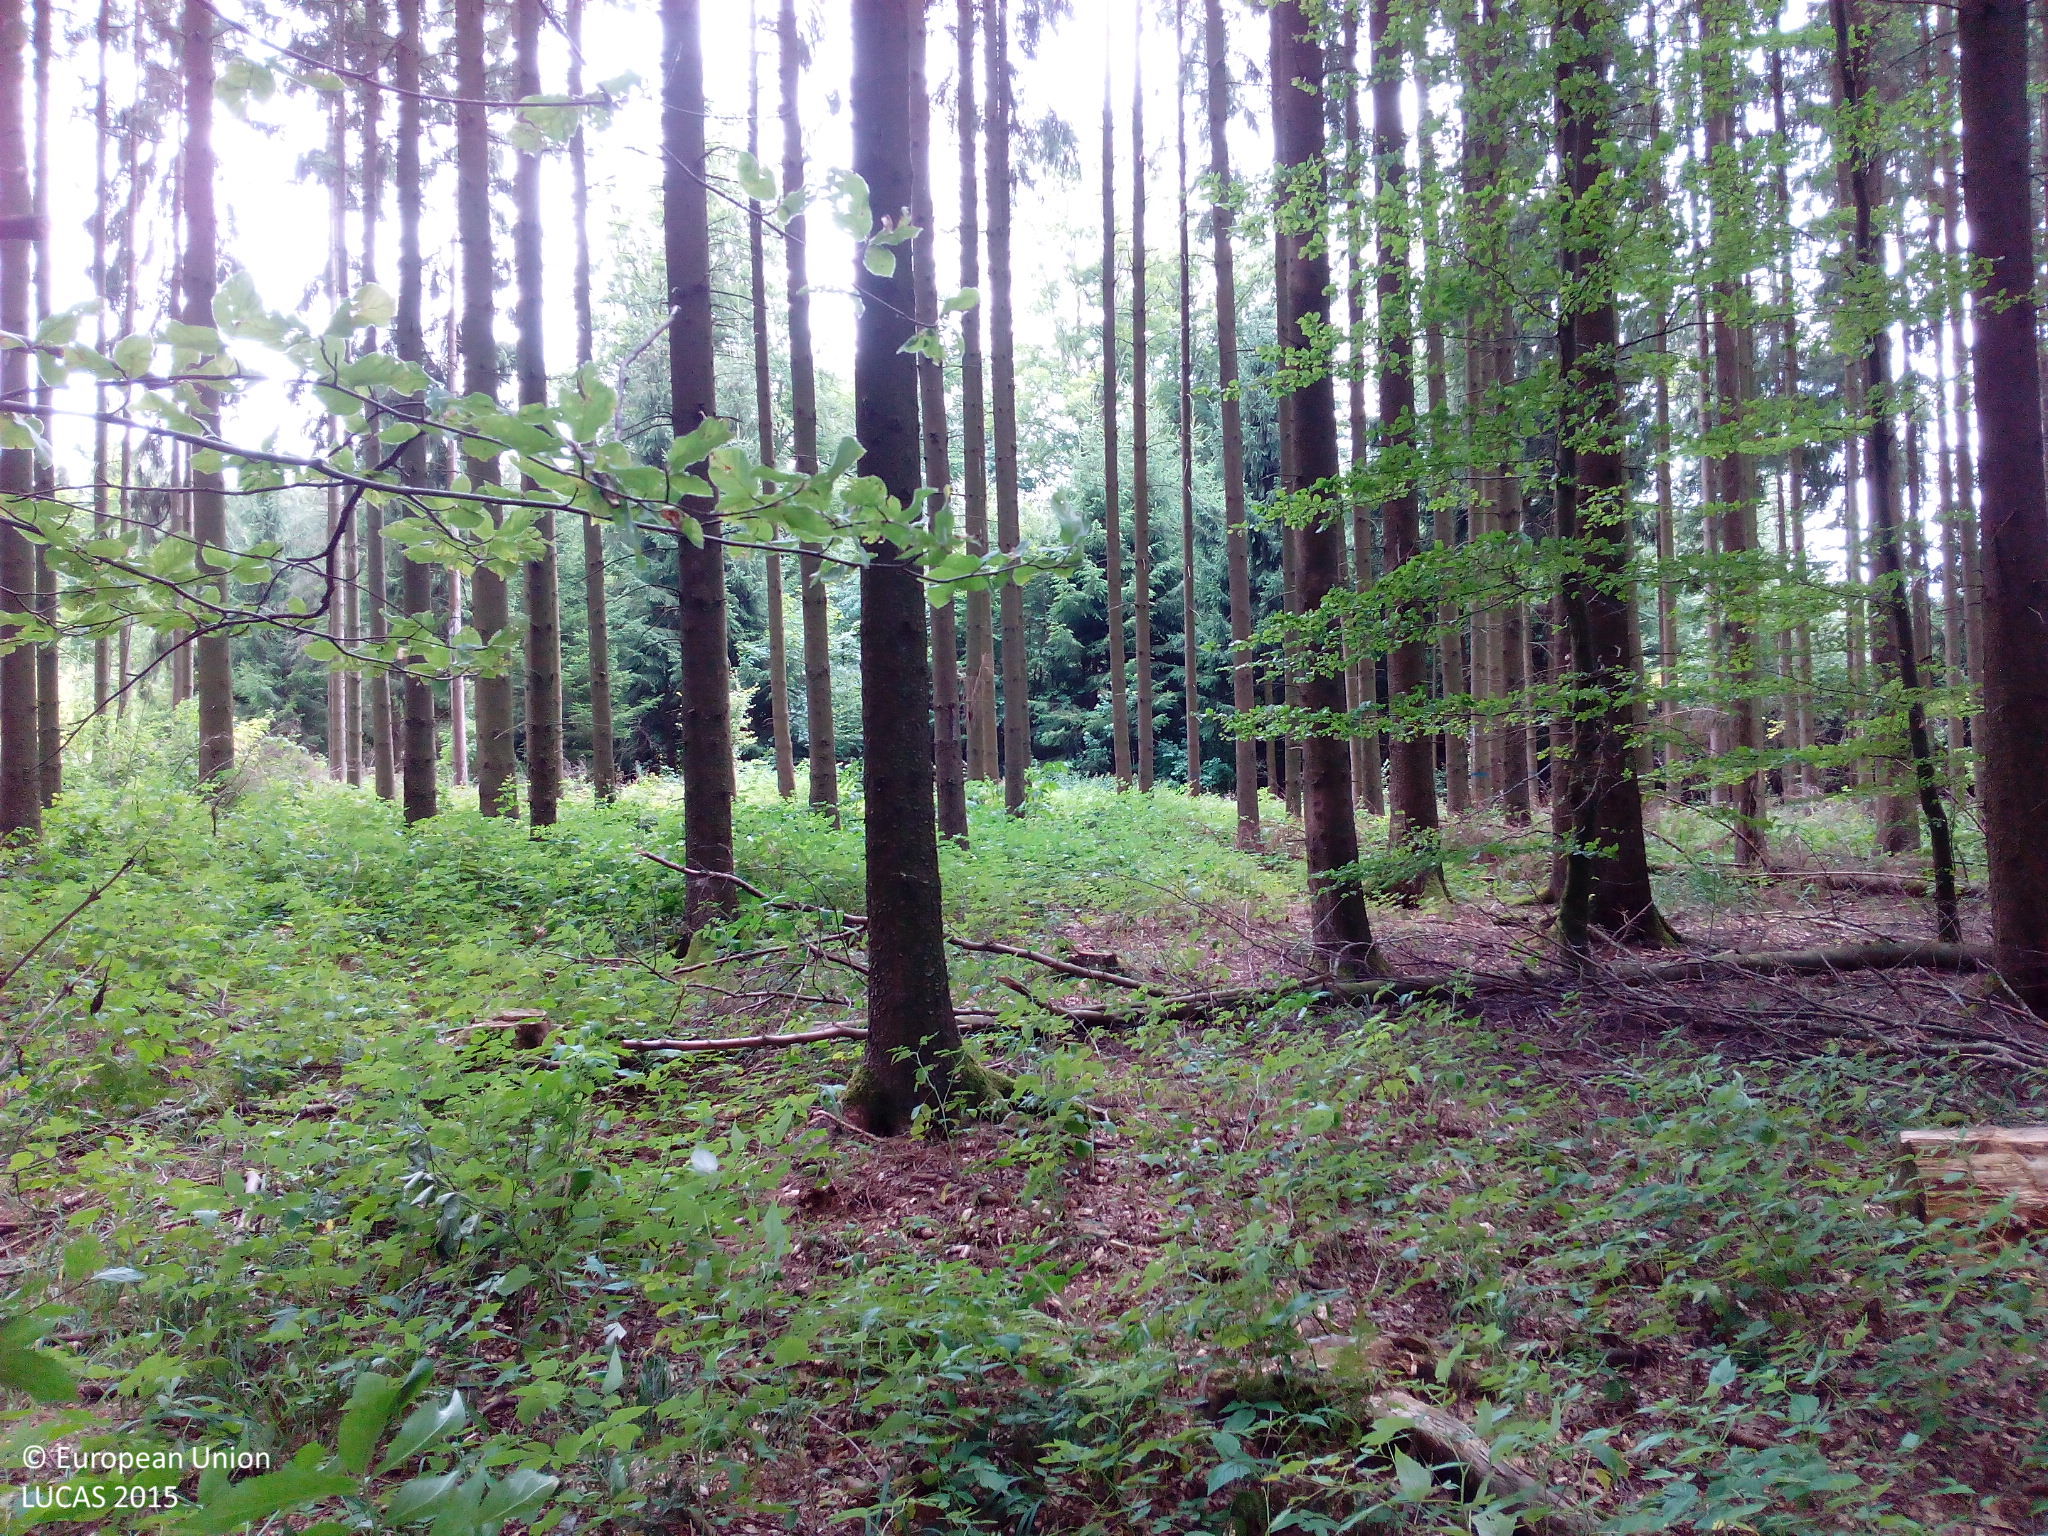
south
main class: Woodland
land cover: Spruce dominated mixed woodland
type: hemiboreal forest and nemoral coniferous forest and mixed broadleaved-coniferous forest
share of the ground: > 75 %
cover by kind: broadleaved forest trees 40 %, coniferous forest trees 35 %, unconsolidated bare surface 20 %, herbaceous plants 5 %
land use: Forestry
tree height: > 5 m
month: July
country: DE
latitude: 48.8170
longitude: 10.2586
